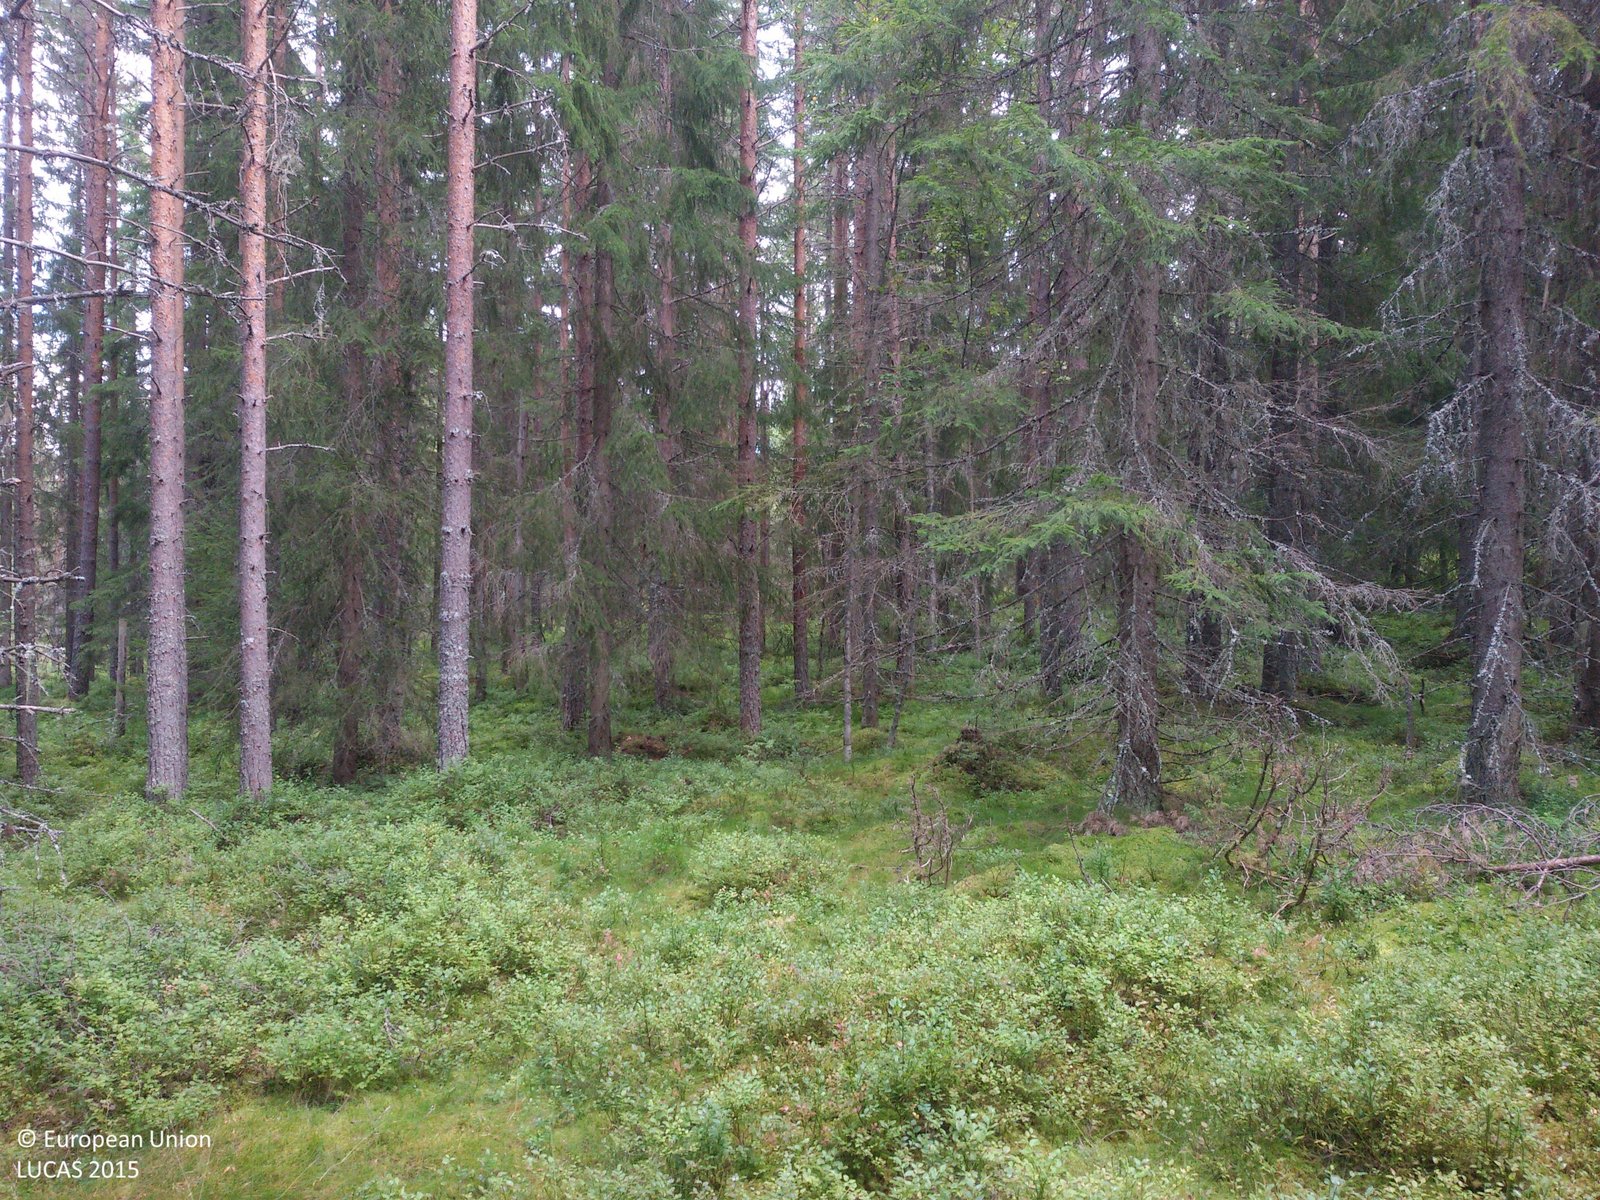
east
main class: Woodland
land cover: Pine dominated coniferous woodland
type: boreal forest
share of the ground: 50 - 75 %
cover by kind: coniferous forest trees 60 %, shrubs 20 %, herbaceous plants 10 %, lichens and mosses 10 %
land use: Forestry
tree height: > 5 m
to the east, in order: Pine dominated coniferous woodland; Pine dominated mixed woodland; Paved roads, cycling and walking lanes; Pine dominated mixed woodland
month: August
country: SE
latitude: 60.7977
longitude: 15.4438
